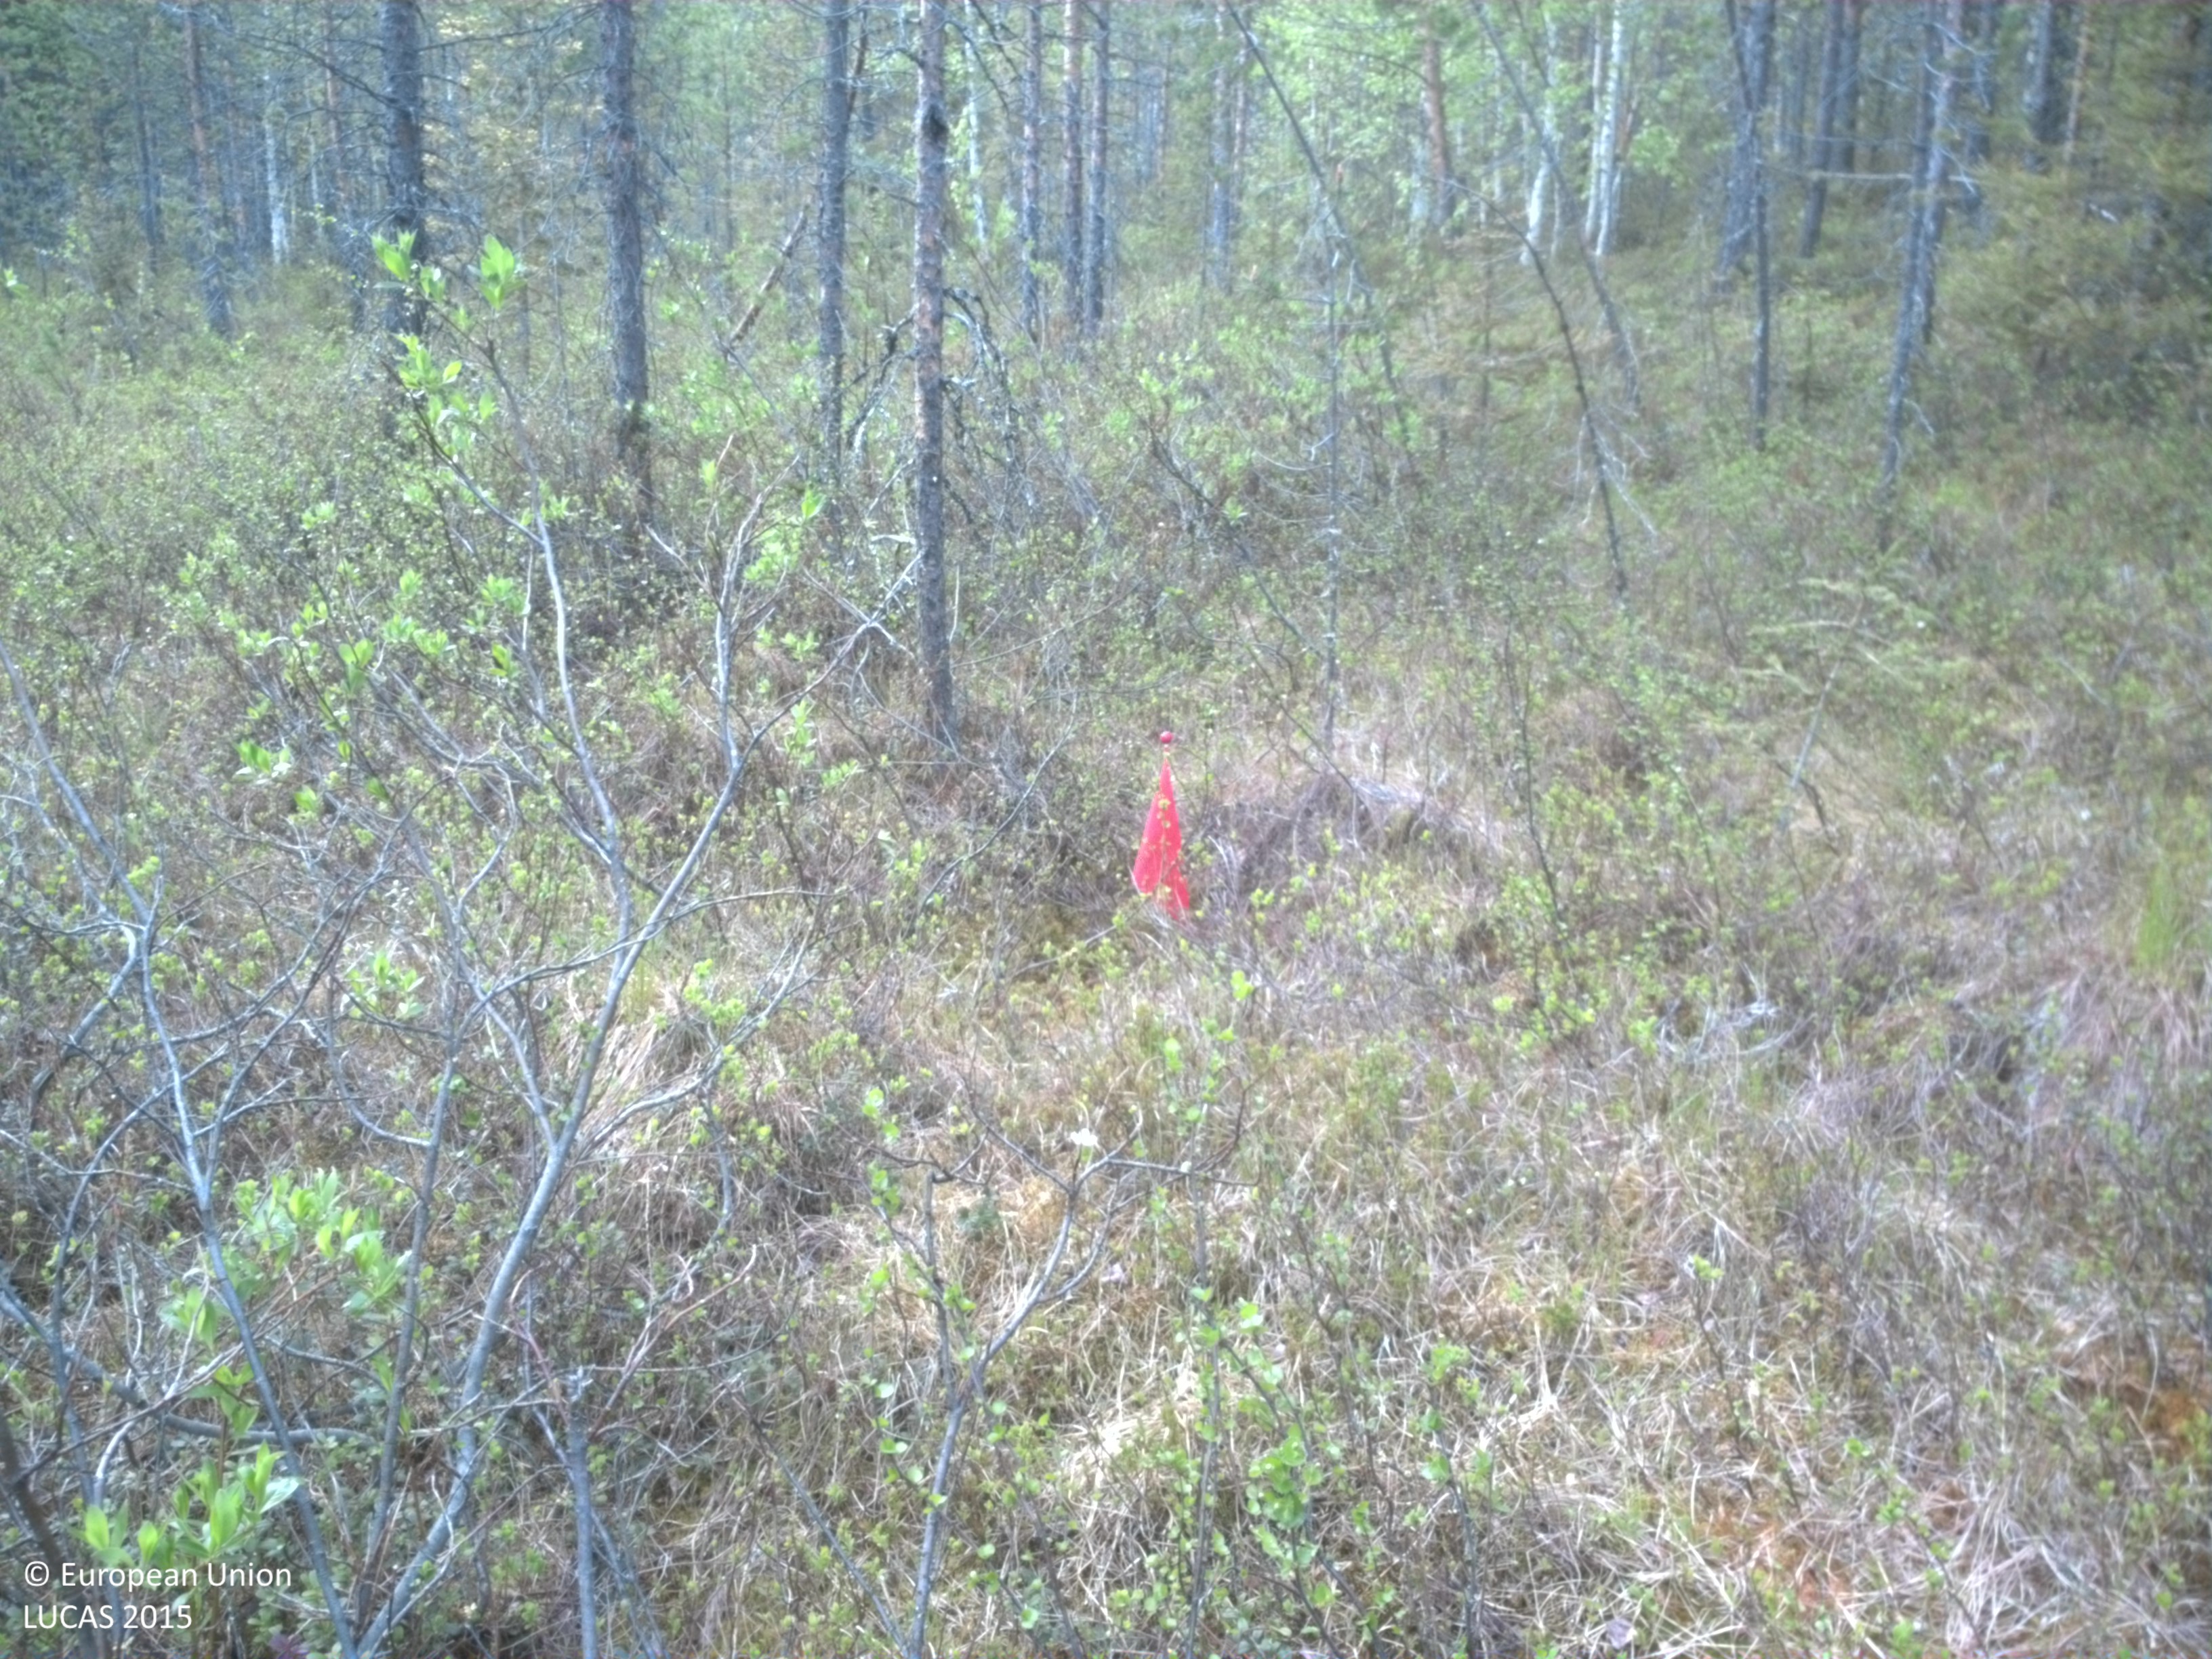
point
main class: Woodland
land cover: Pine dominated coniferous woodland
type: boreal forest
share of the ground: 25 - 50 %
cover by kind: shrubs 70 %, coniferous forest trees 20 %, broadleaved forest trees 5 %, lichens and mosses 5 %
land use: Forestry
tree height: > 5 m
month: June
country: SE
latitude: 66.9268
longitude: 21.7810
